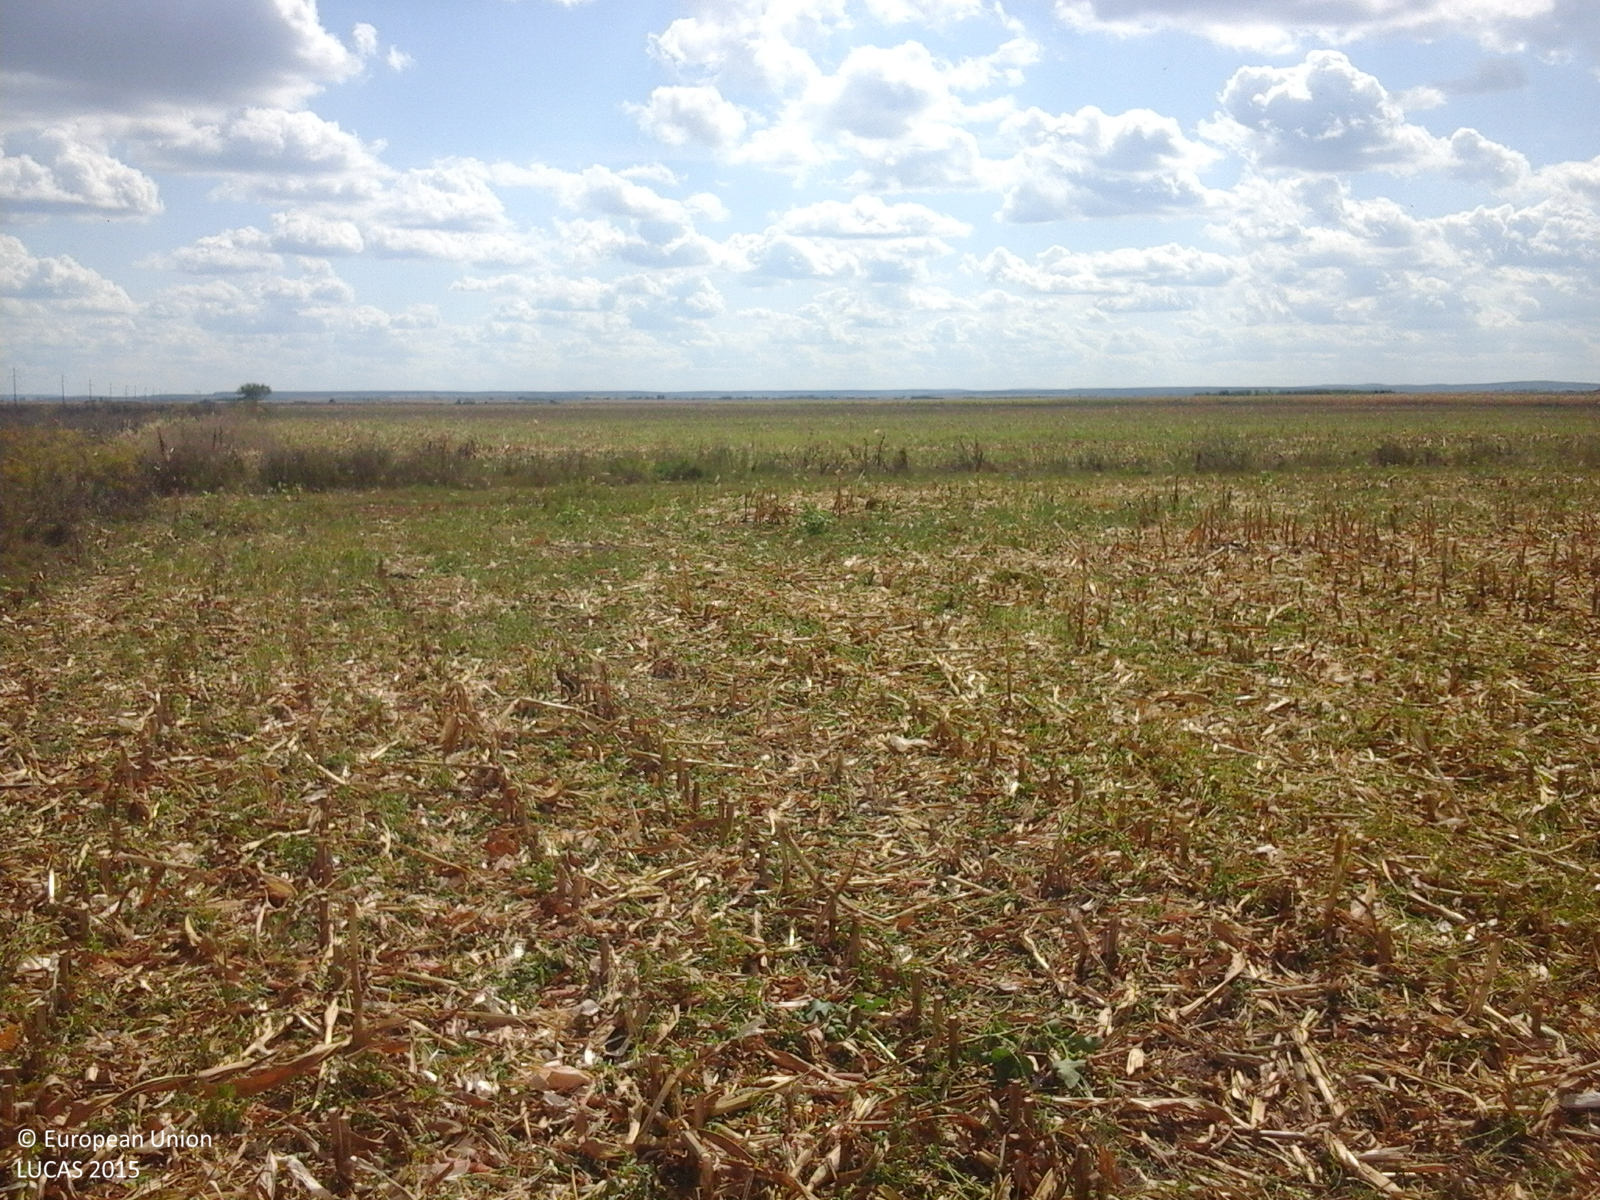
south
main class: Cropland
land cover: Maize
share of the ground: 10 - 25 %
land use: Agriculture (excluding fallow land and kitchen gardens)
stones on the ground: < 10 %
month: September
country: RO
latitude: 47.5499
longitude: 22.6160
